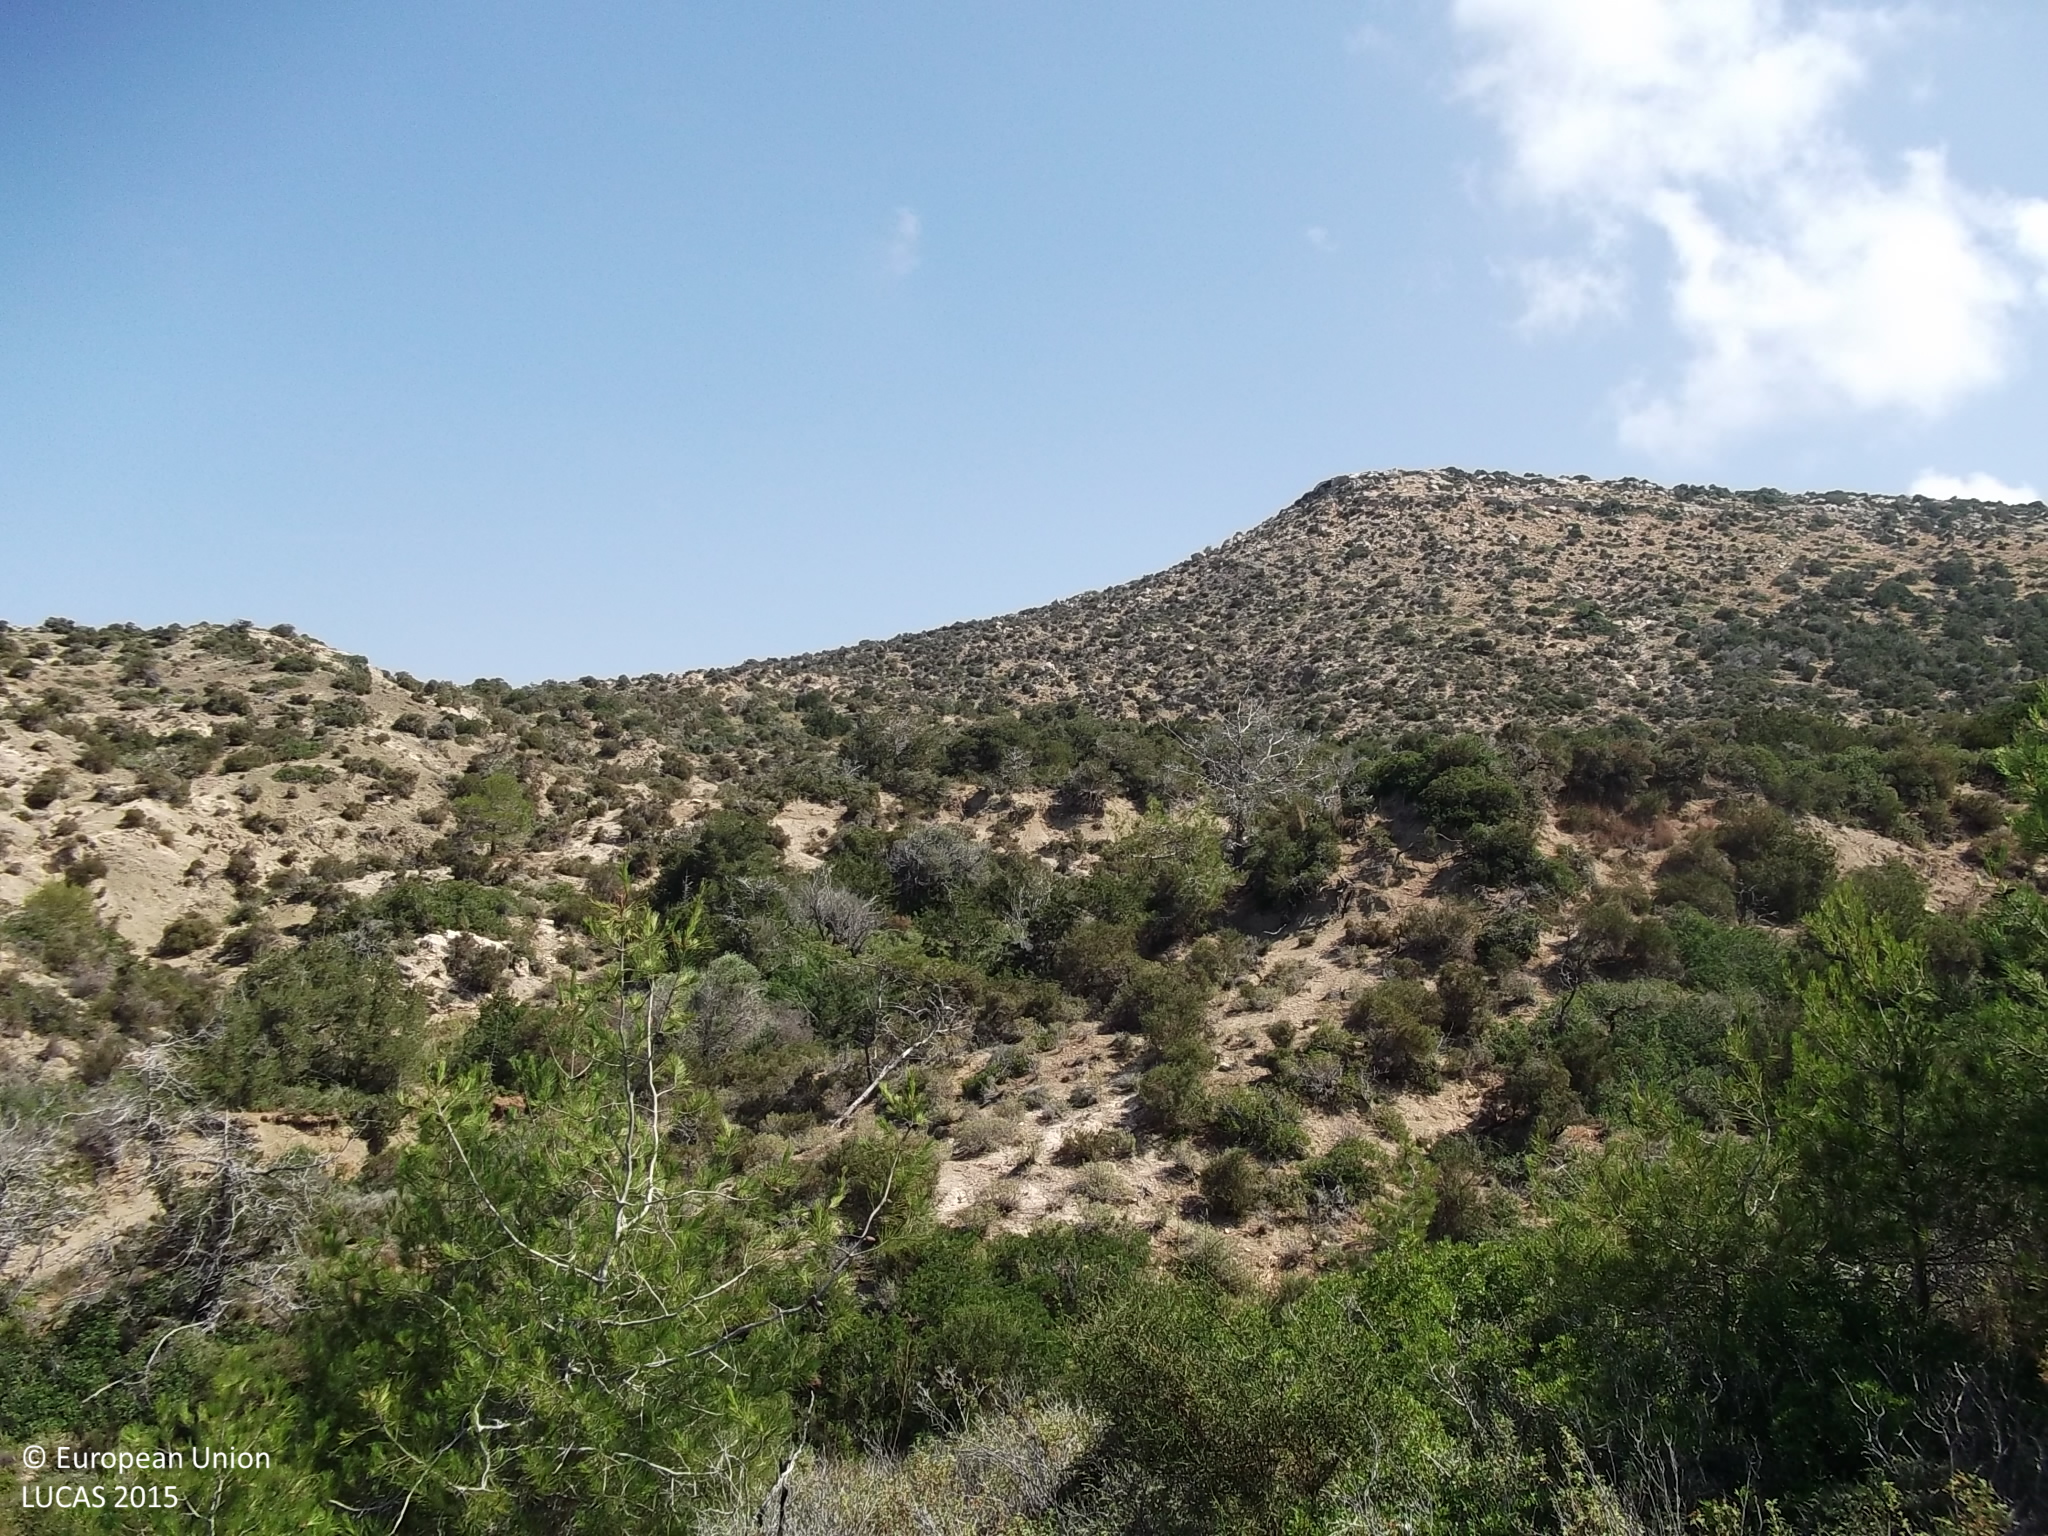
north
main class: Shrubland
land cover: Shrubland with sparse tree cover
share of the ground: > 75 %
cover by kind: shrubs 85 %, unconsolidated bare surface 10 %, broadleaved forest trees 5 %
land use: Agriculture (excluding fallow land and kitchen gardens)
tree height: < 5 m
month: May
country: CY
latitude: 35.0663
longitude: 32.2889
